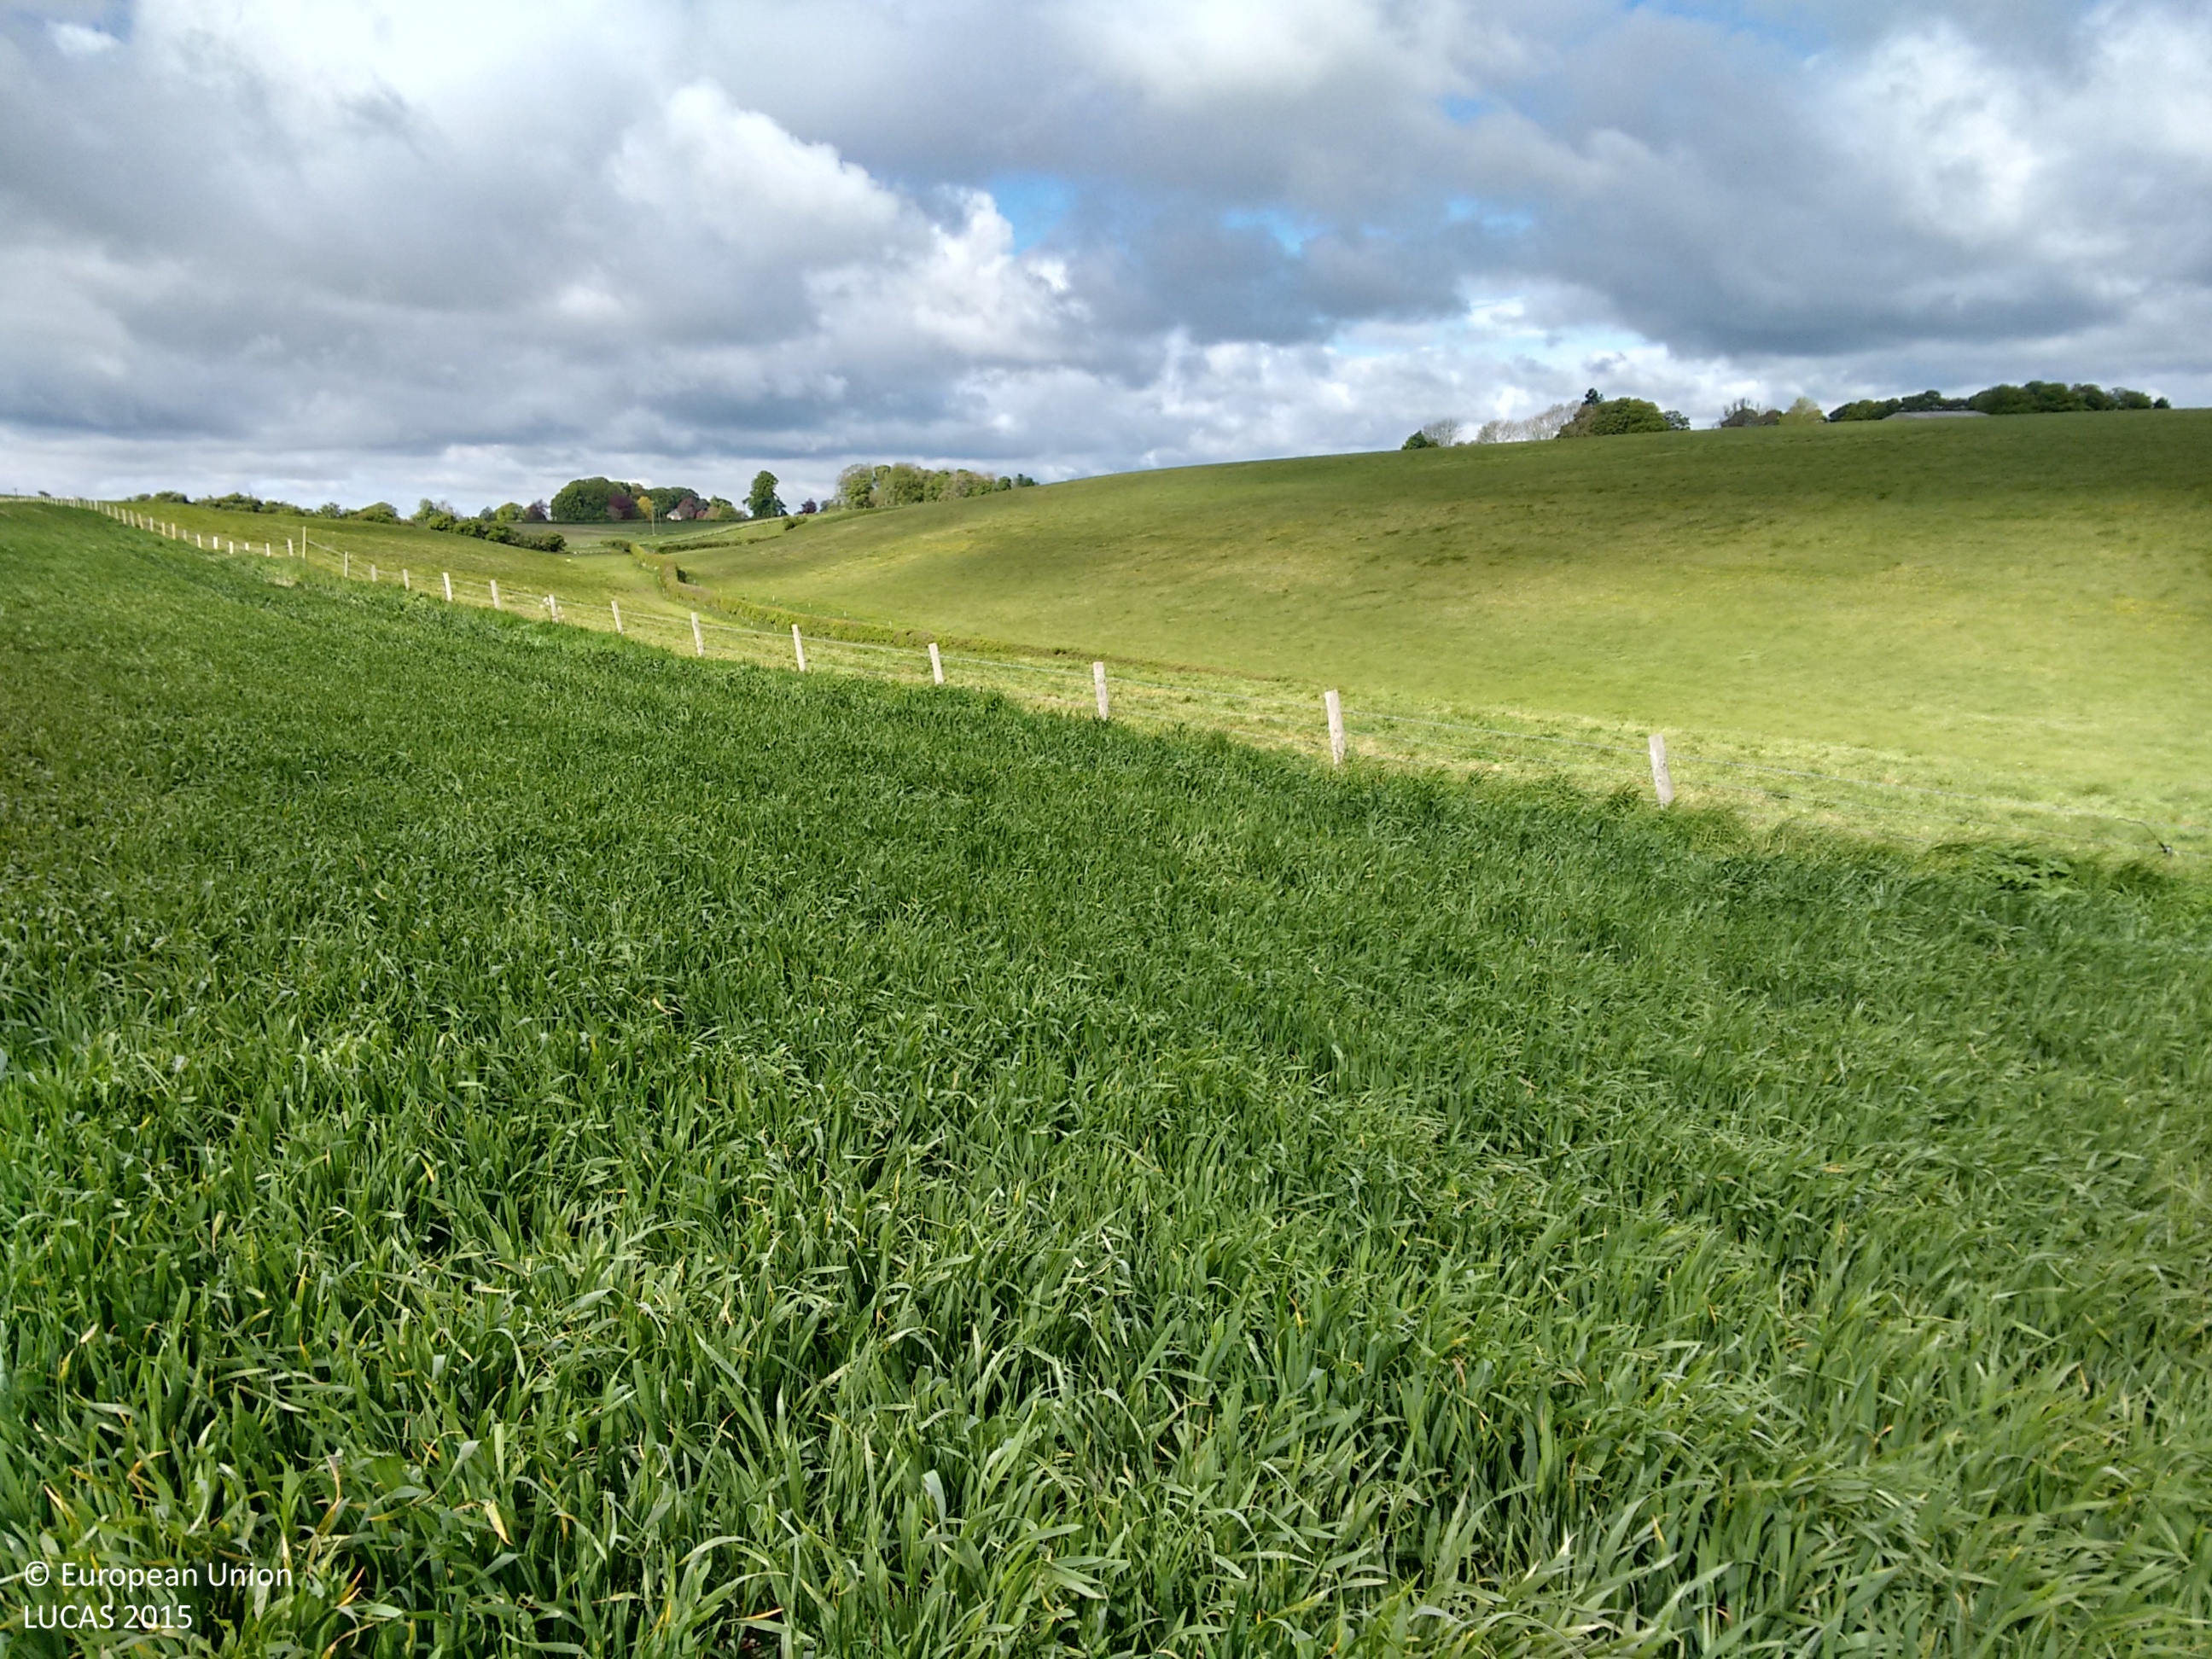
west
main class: Cropland
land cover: Common wheat
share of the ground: > 75 %
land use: Agriculture (excluding fallow land and kitchen gardens)
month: May
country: GB
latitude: 53.3985
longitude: -0.0638
